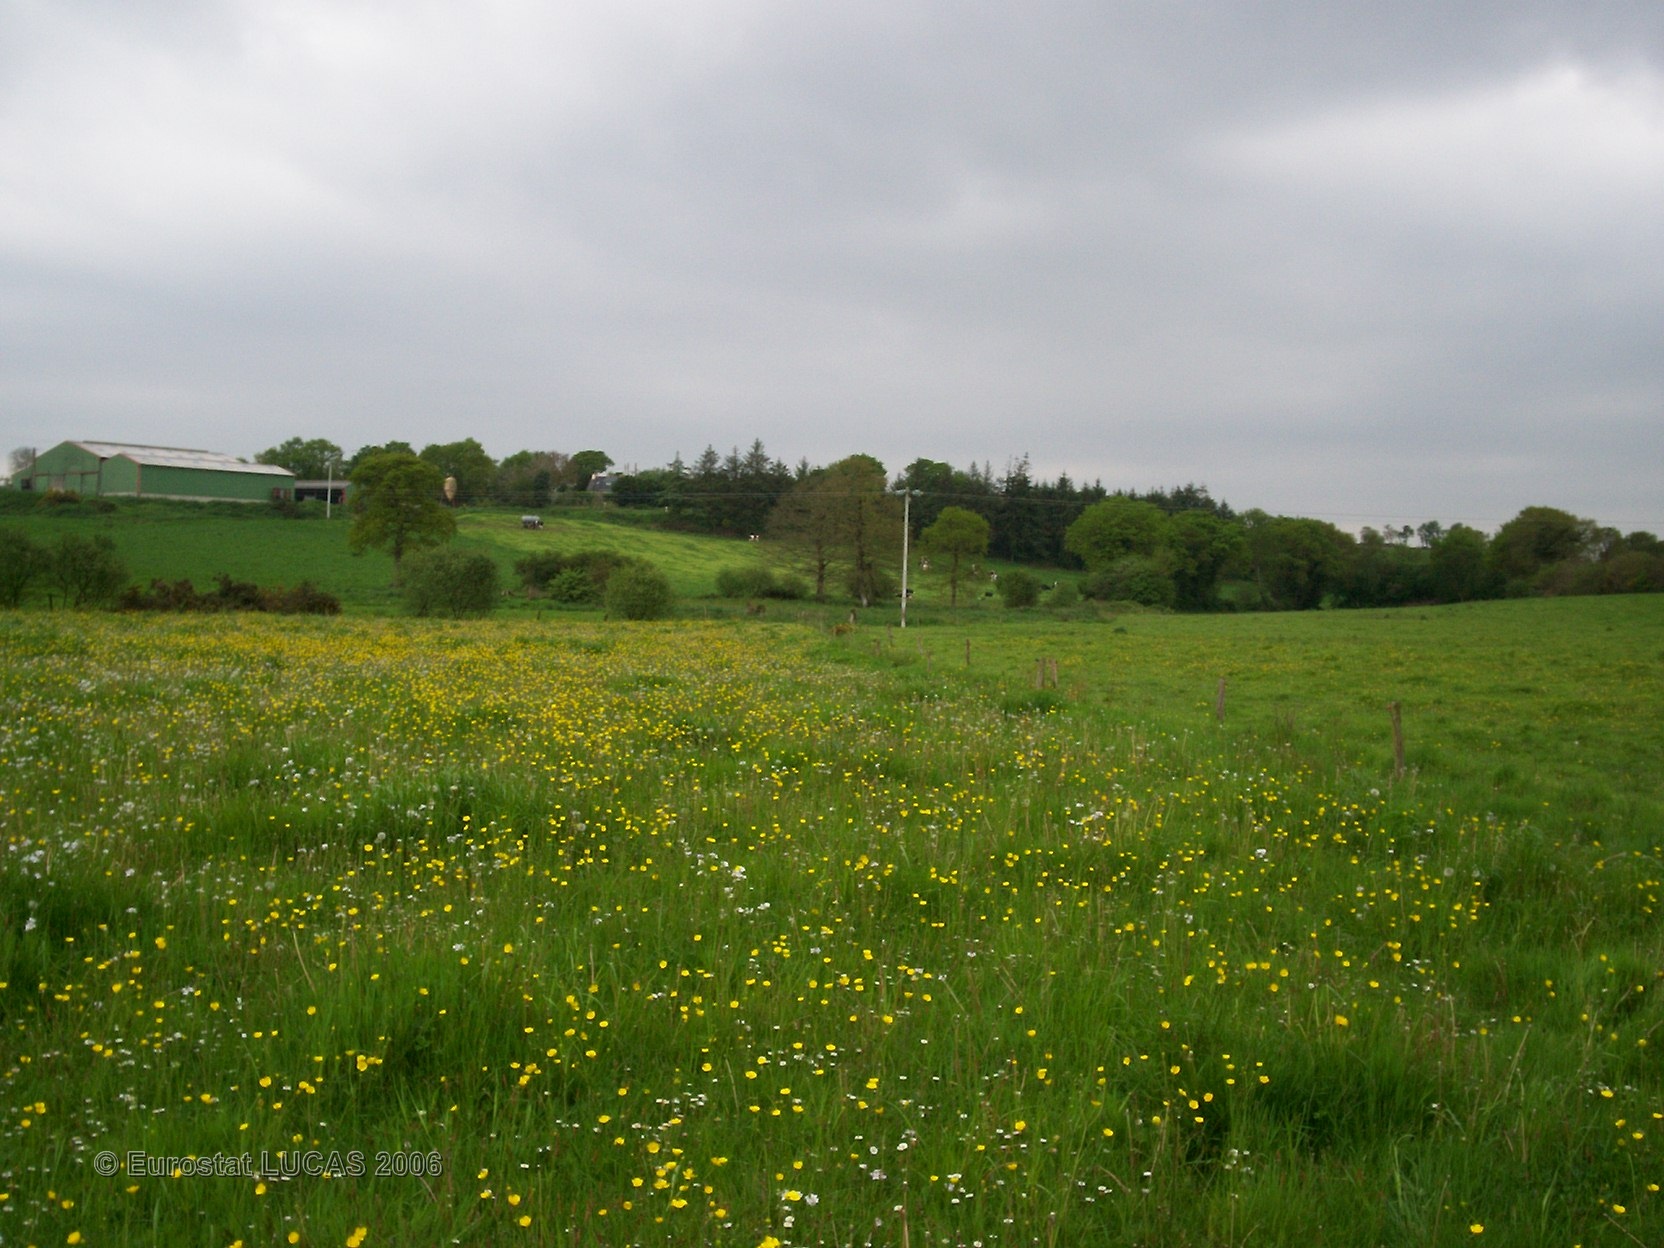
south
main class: Grassland
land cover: Grassland without tree/shrub cover
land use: Agriculture (excluding fallow land and kitchen gardens)
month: May
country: FR
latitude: 48.2784
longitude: -3.6777
